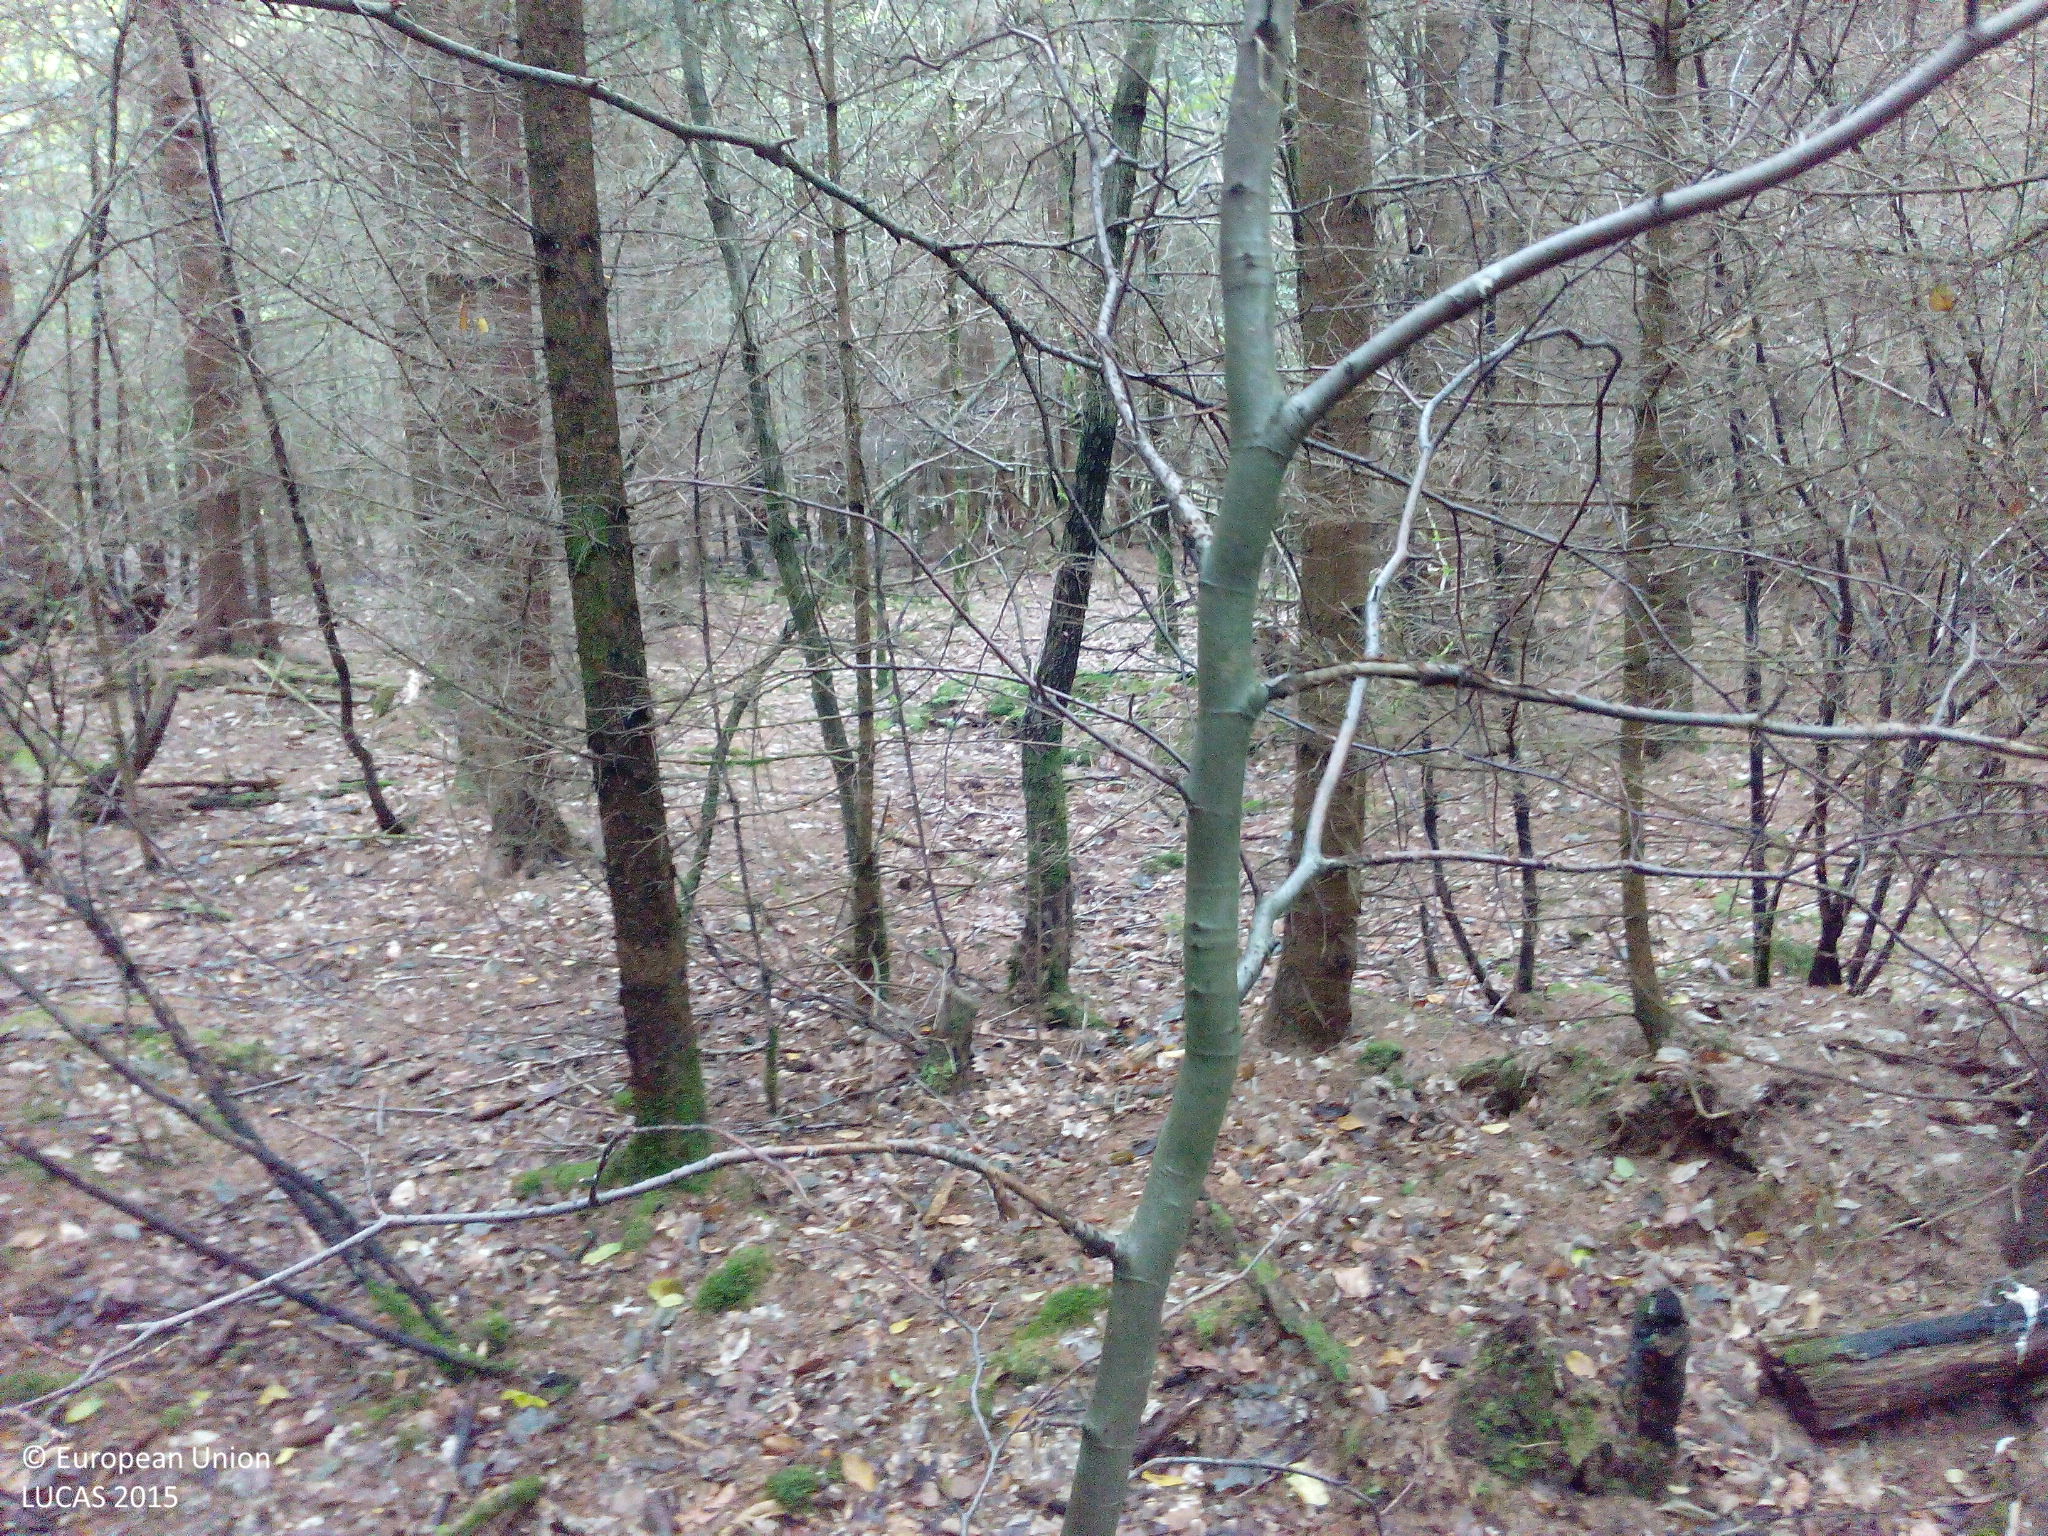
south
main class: Woodland
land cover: Spruce dominated mixed woodland
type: mesophytic deciduous forest
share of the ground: > 75 %
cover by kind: coniferous forest trees 45 %, broadleaved forest trees 45 %, unconsolidated bare surface 10 %
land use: Forestry
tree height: > 5 m
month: August
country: DE
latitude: 50.0687
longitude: 7.5833
